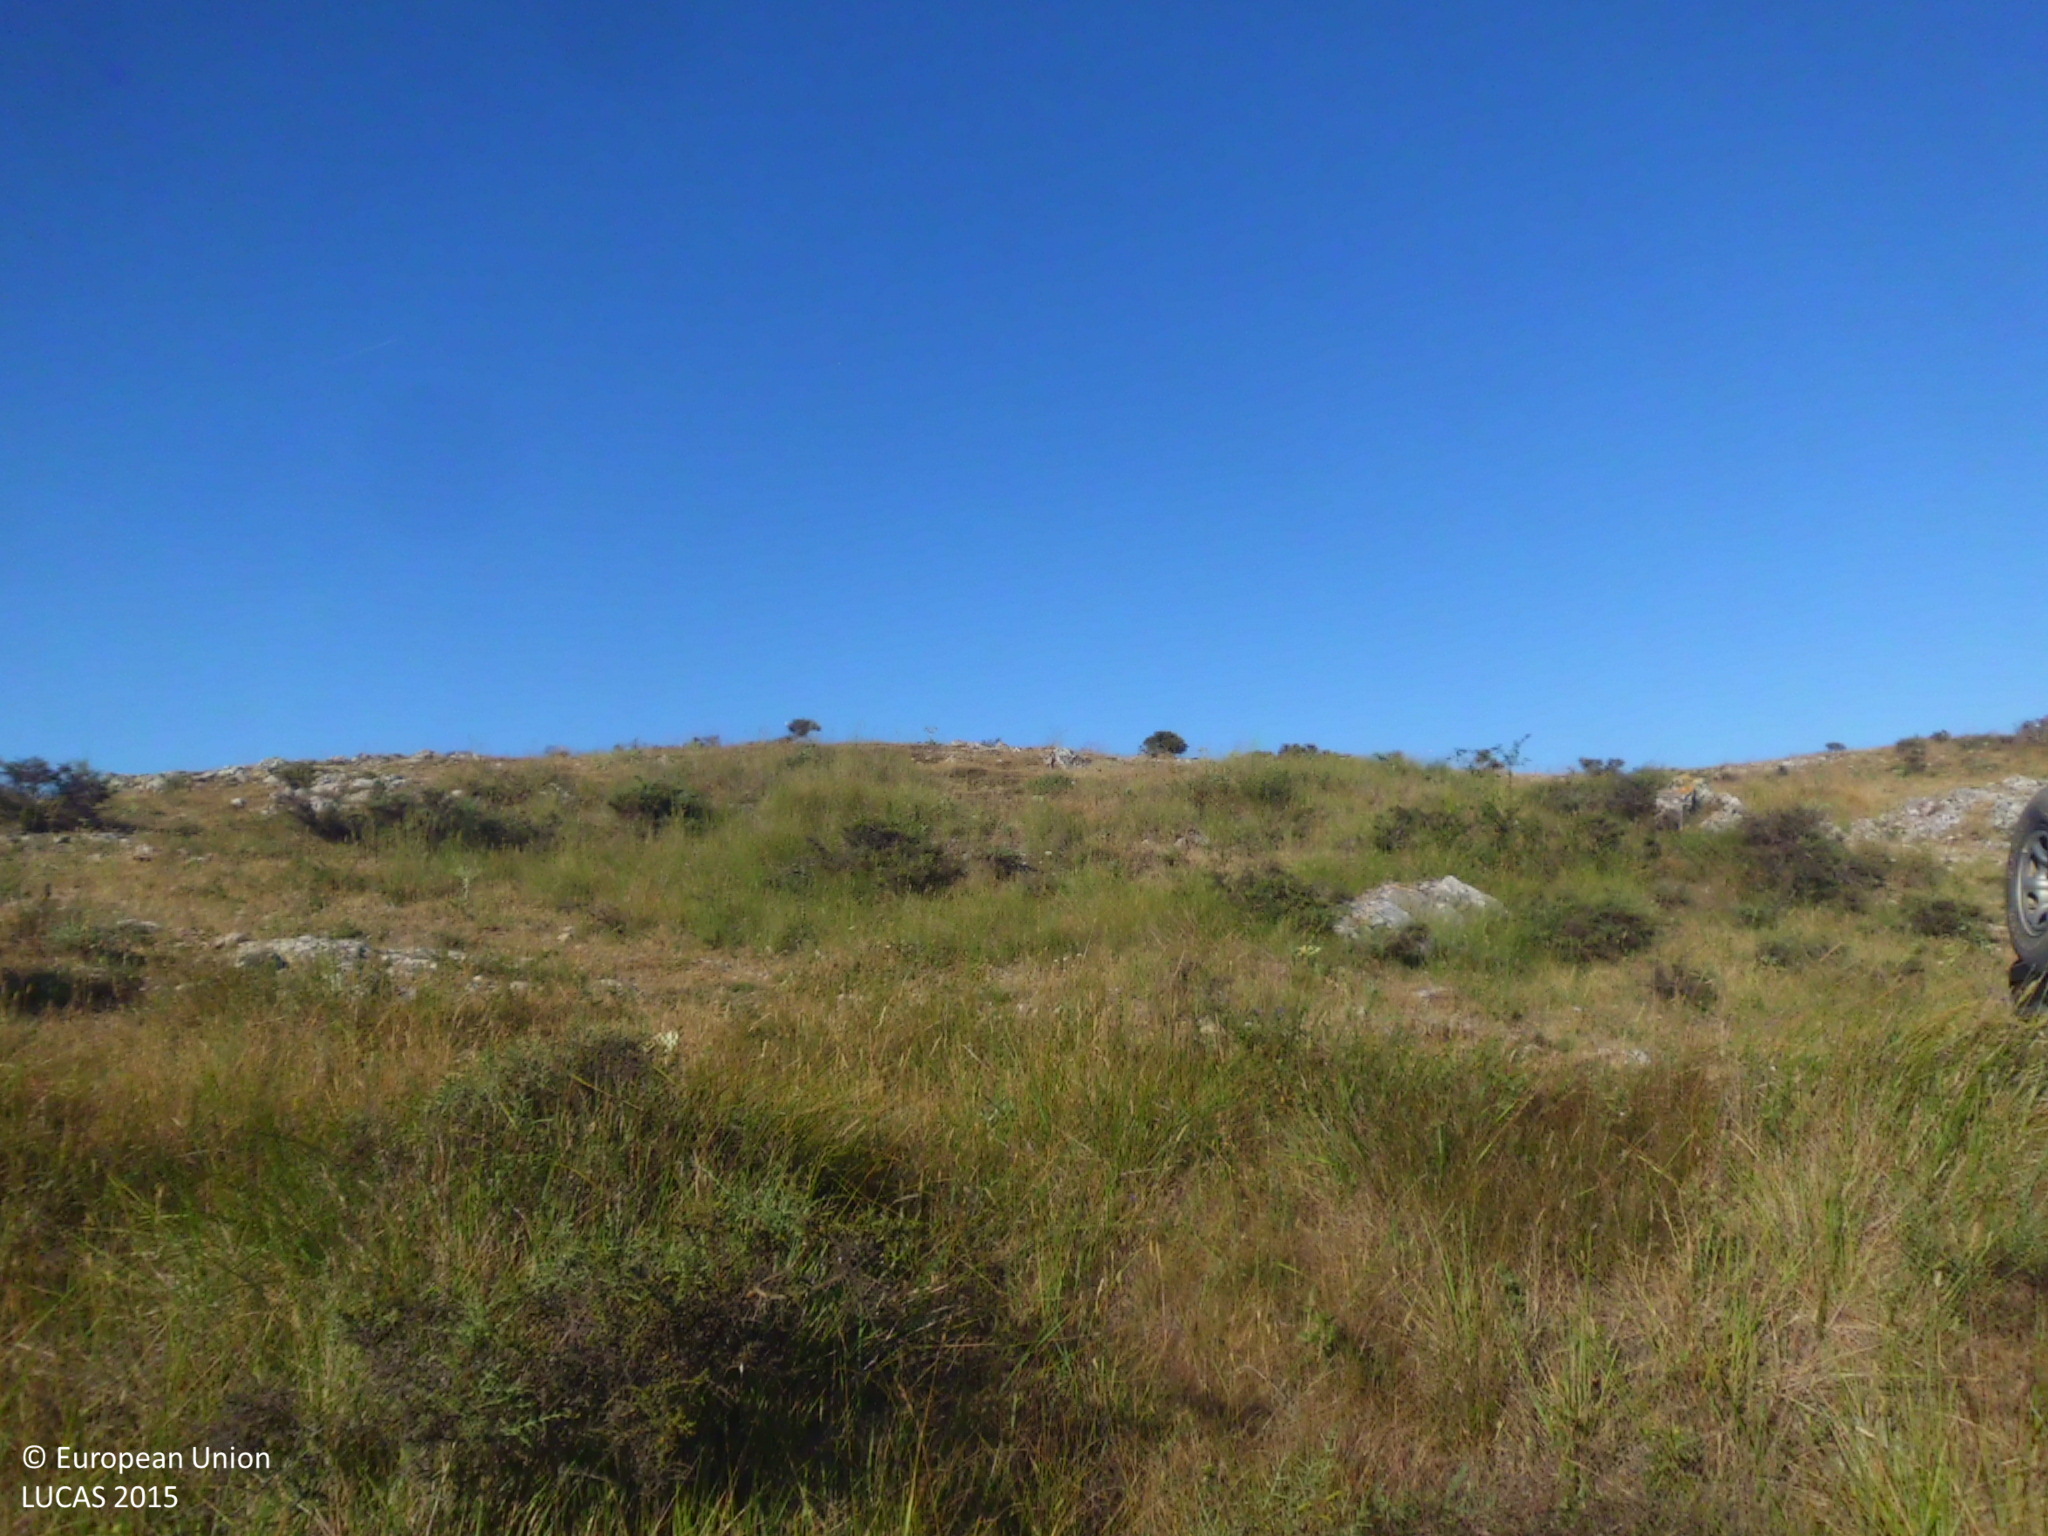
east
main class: Shrubland
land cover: Shrubland without tree cover
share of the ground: 50 - 75 %
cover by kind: shrubs 65 %, consolidated bare surface 20 %, herbaceous plants 15 %
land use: Abandoned areas
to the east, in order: Shrubland without tree cover; Rock outcrops; Shrubland without tree cover; Electric lines; Grassland without tree/shrub cover; Rock outcrops; Fences; Grassland without tree/shrub cover
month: July
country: ES
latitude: 42.6641
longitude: -4.2623
